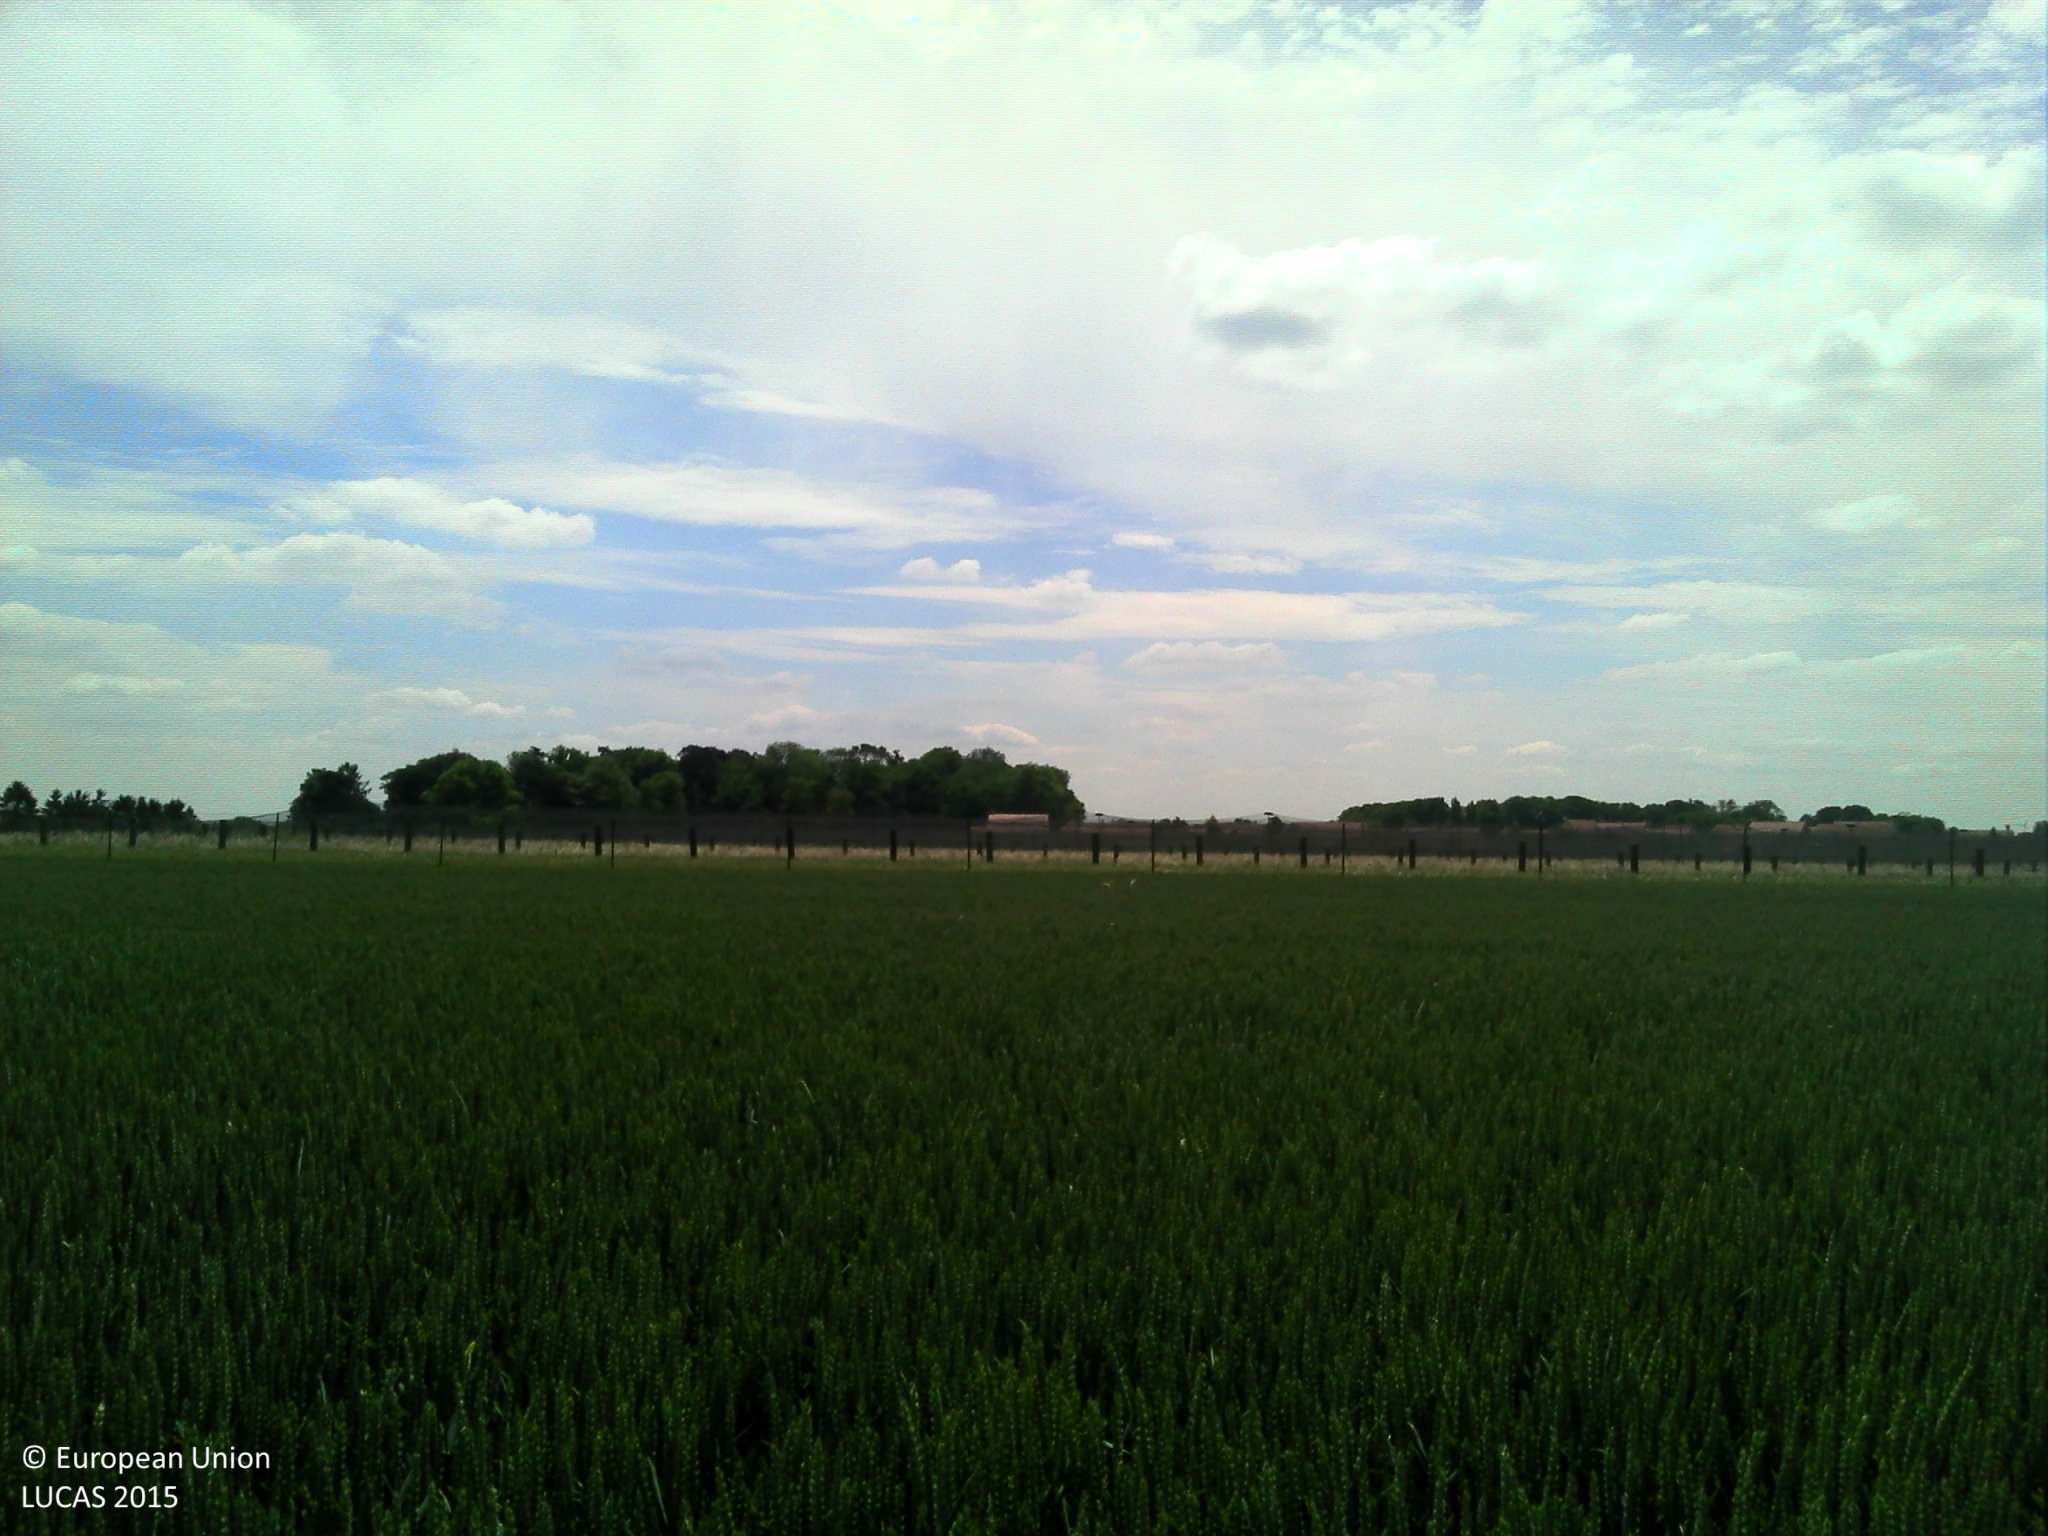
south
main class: Cropland
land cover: Common wheat
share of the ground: > 75 %
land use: Agriculture (excluding fallow land and kitchen gardens)
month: June
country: FR
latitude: 49.5583
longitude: 2.5089
